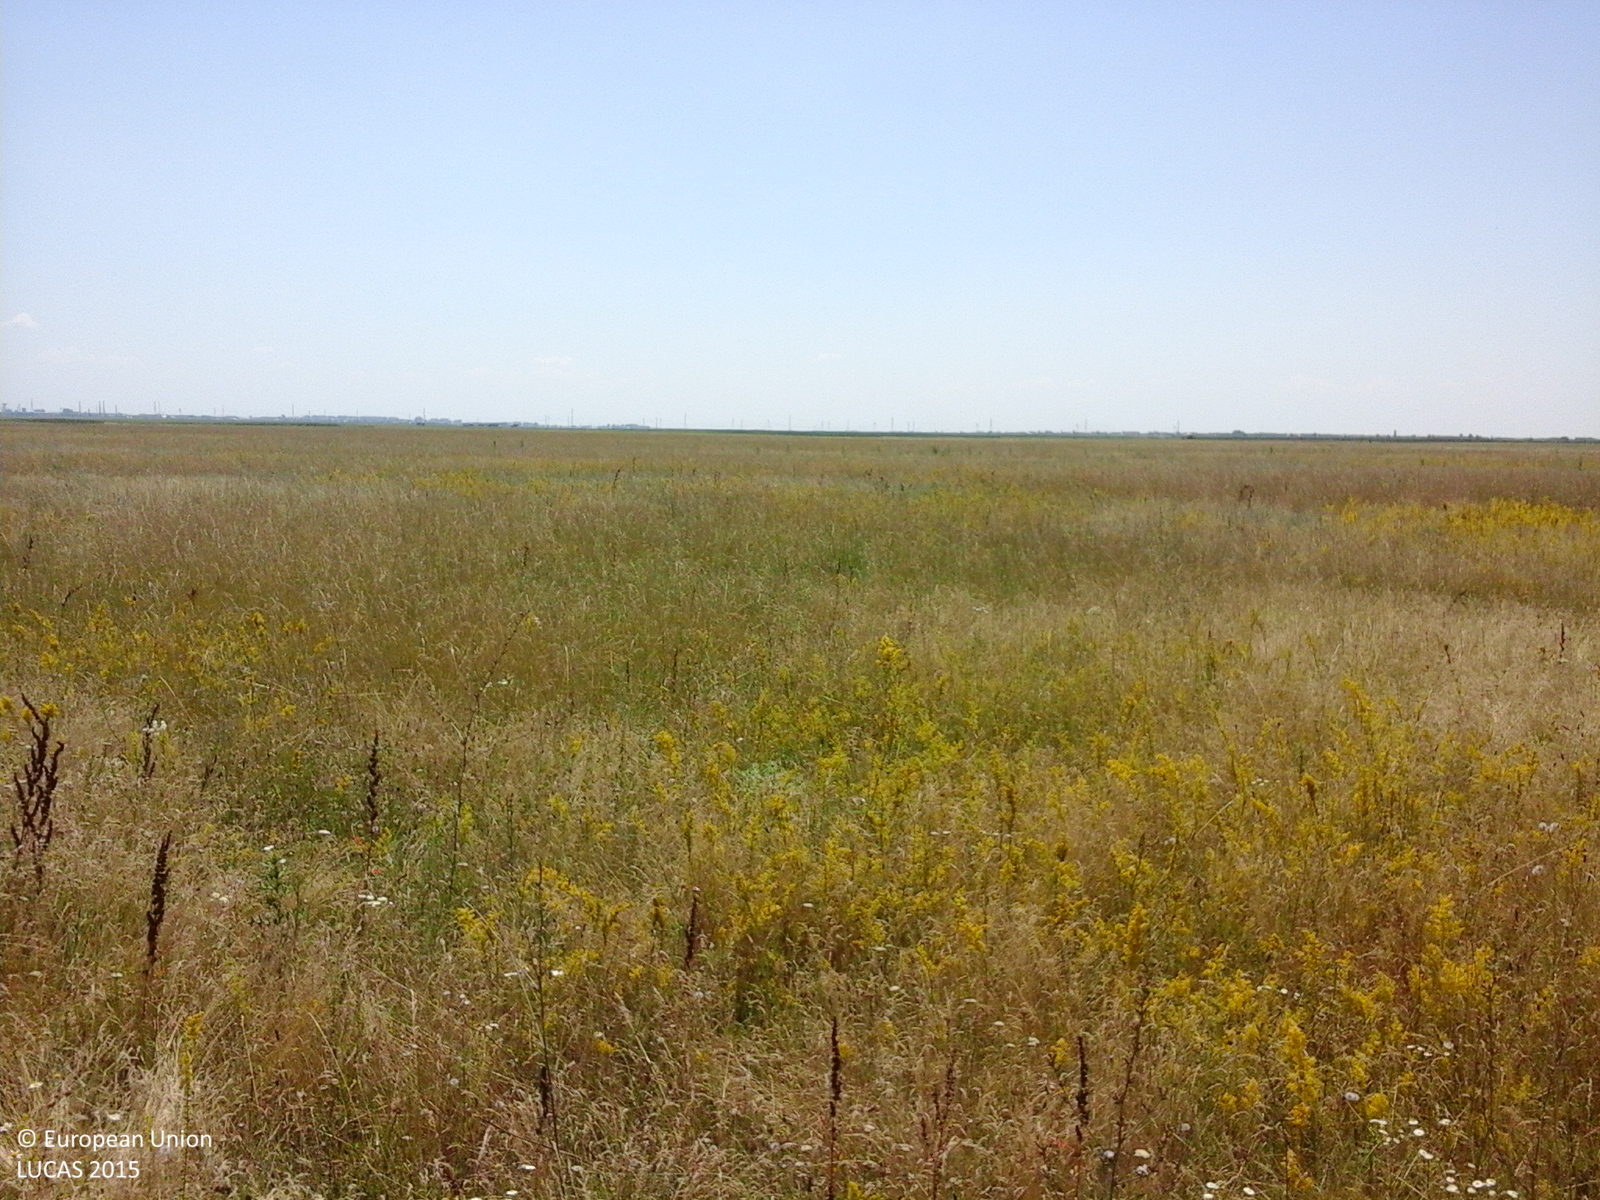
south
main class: Grassland
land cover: Spontaneously vegetated surfaces
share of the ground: > 75 %
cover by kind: herbaceous plants 100 %
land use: Fallow land
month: July
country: RO
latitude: 44.5148
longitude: 24.3724
